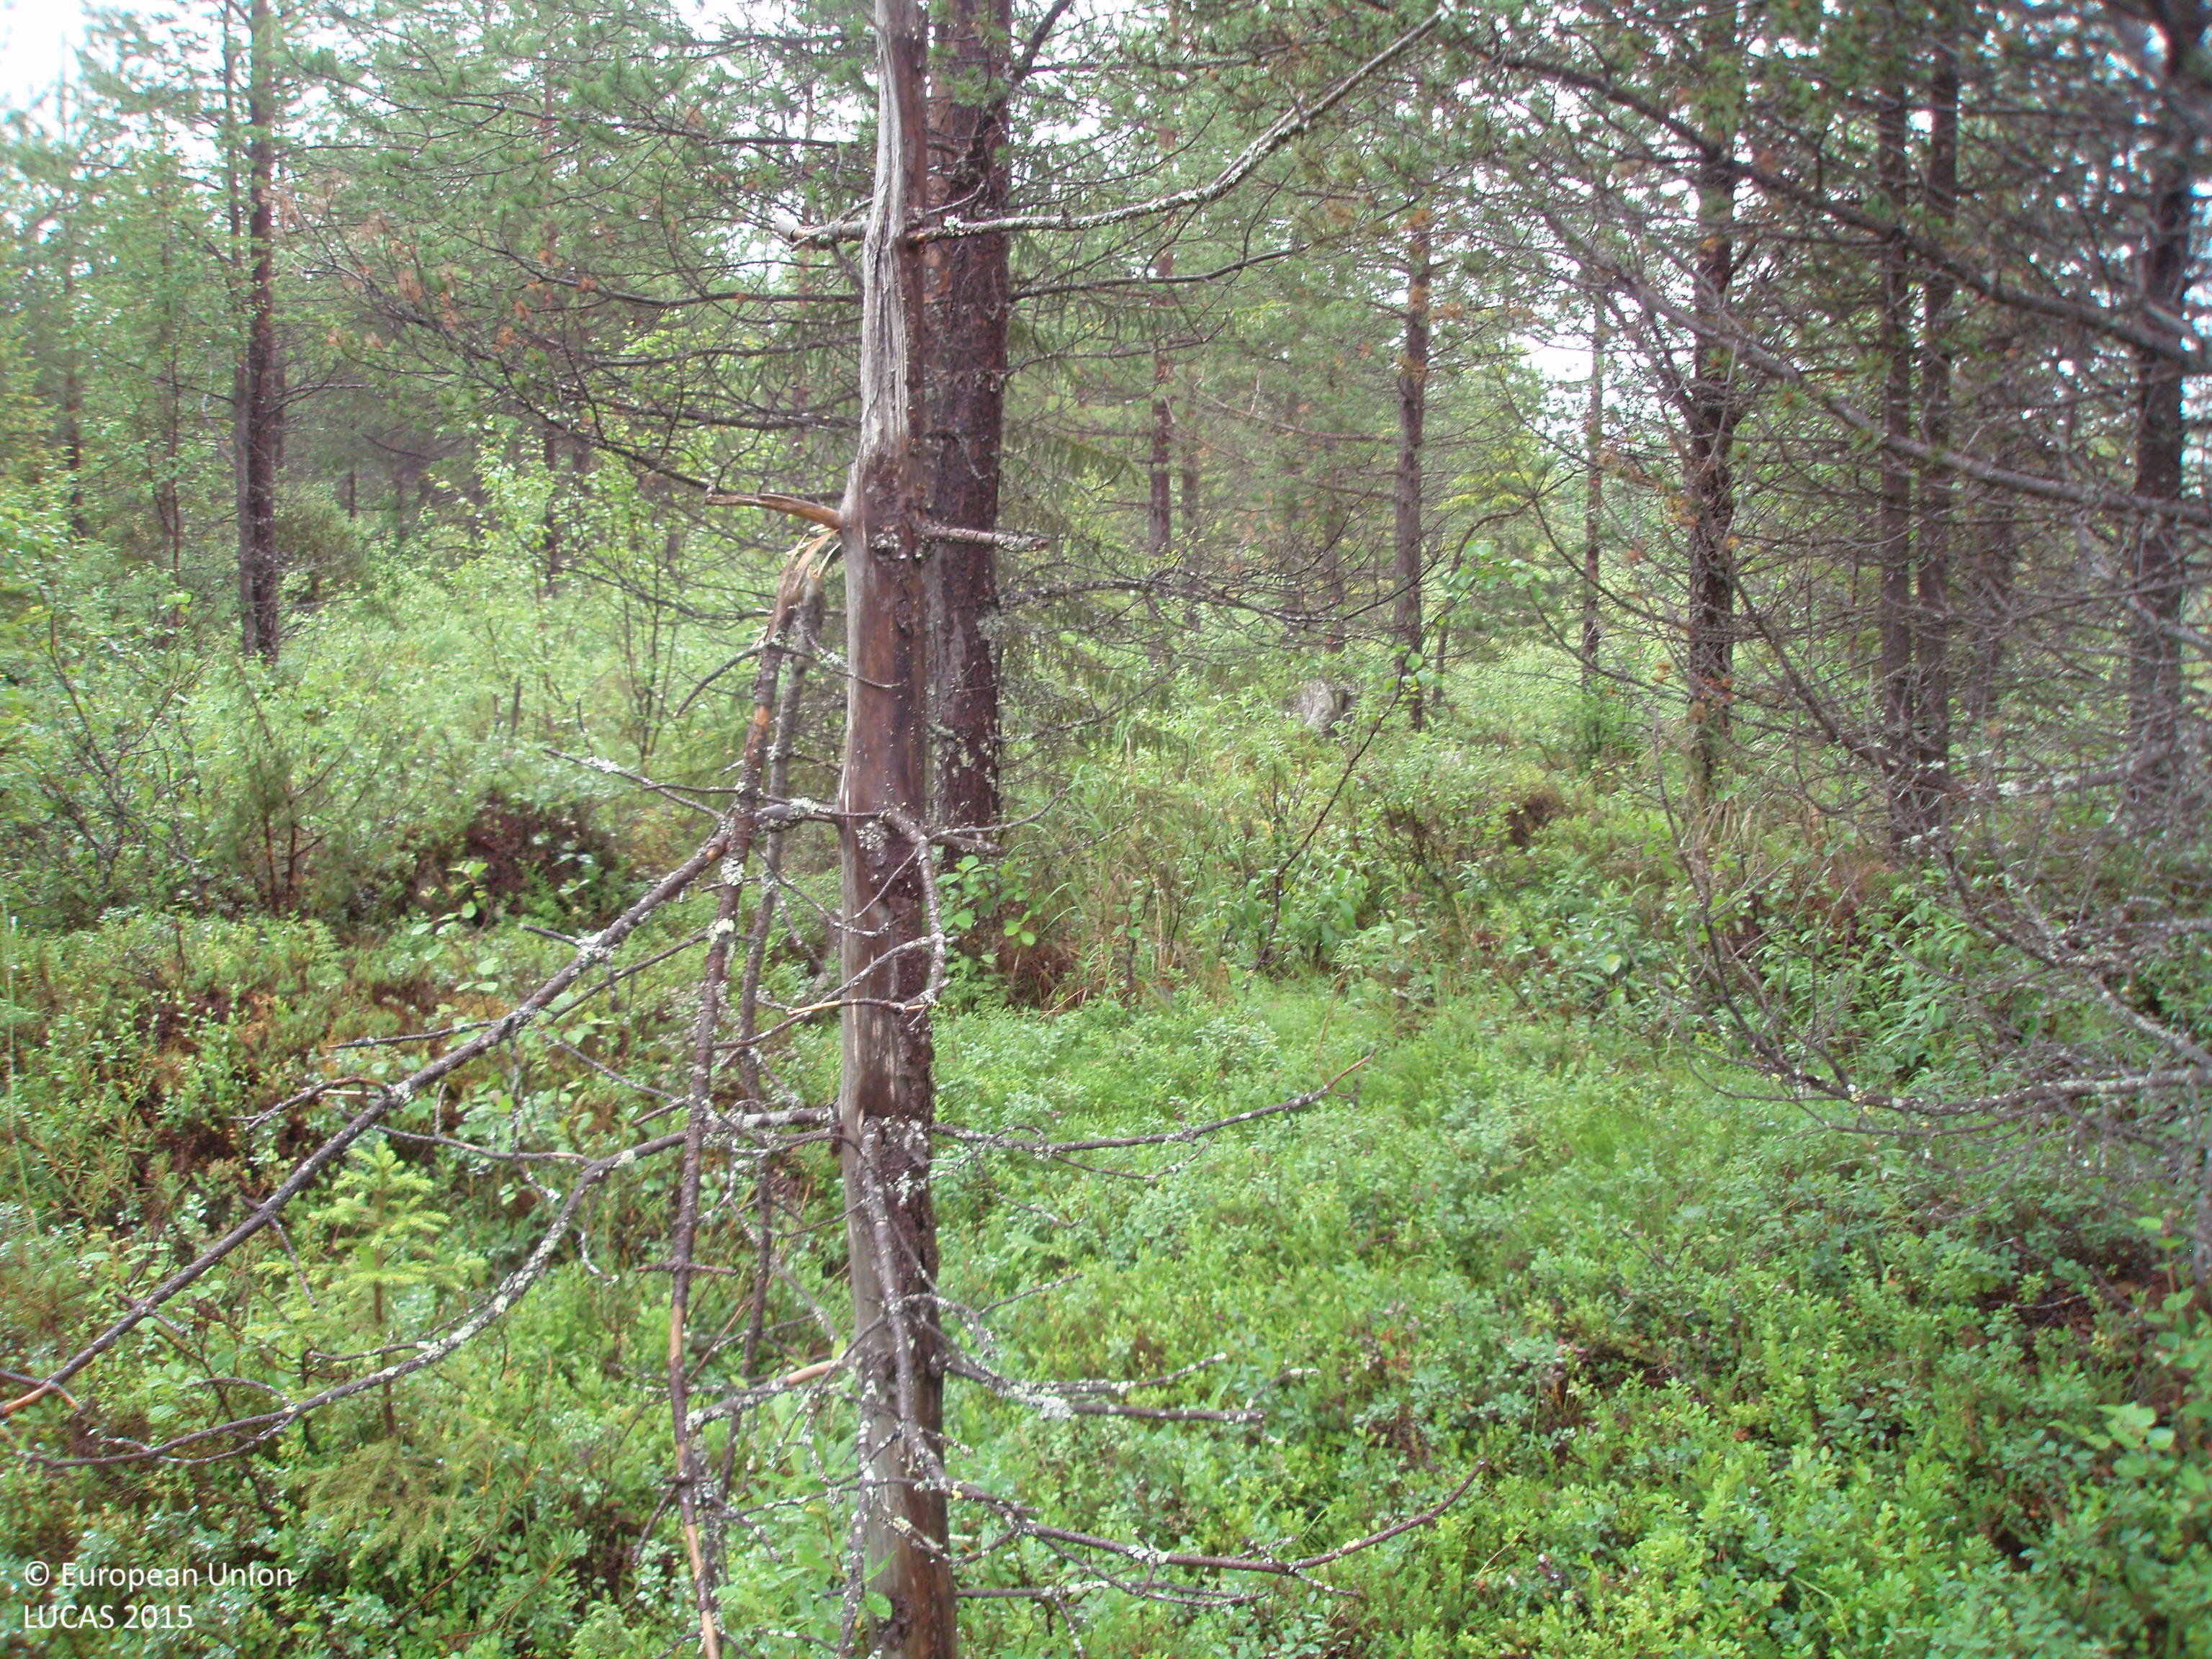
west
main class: Woodland
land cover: Pine dominated coniferous woodland
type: boreal forest
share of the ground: > 75 %
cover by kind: coniferous forest trees 65 %, shrubs 25 %, broadleaved forest trees 10 %
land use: Semi-natural and natural areas not in use
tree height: > 5 m
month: July
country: FI
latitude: 66.7446
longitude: 28.5975
